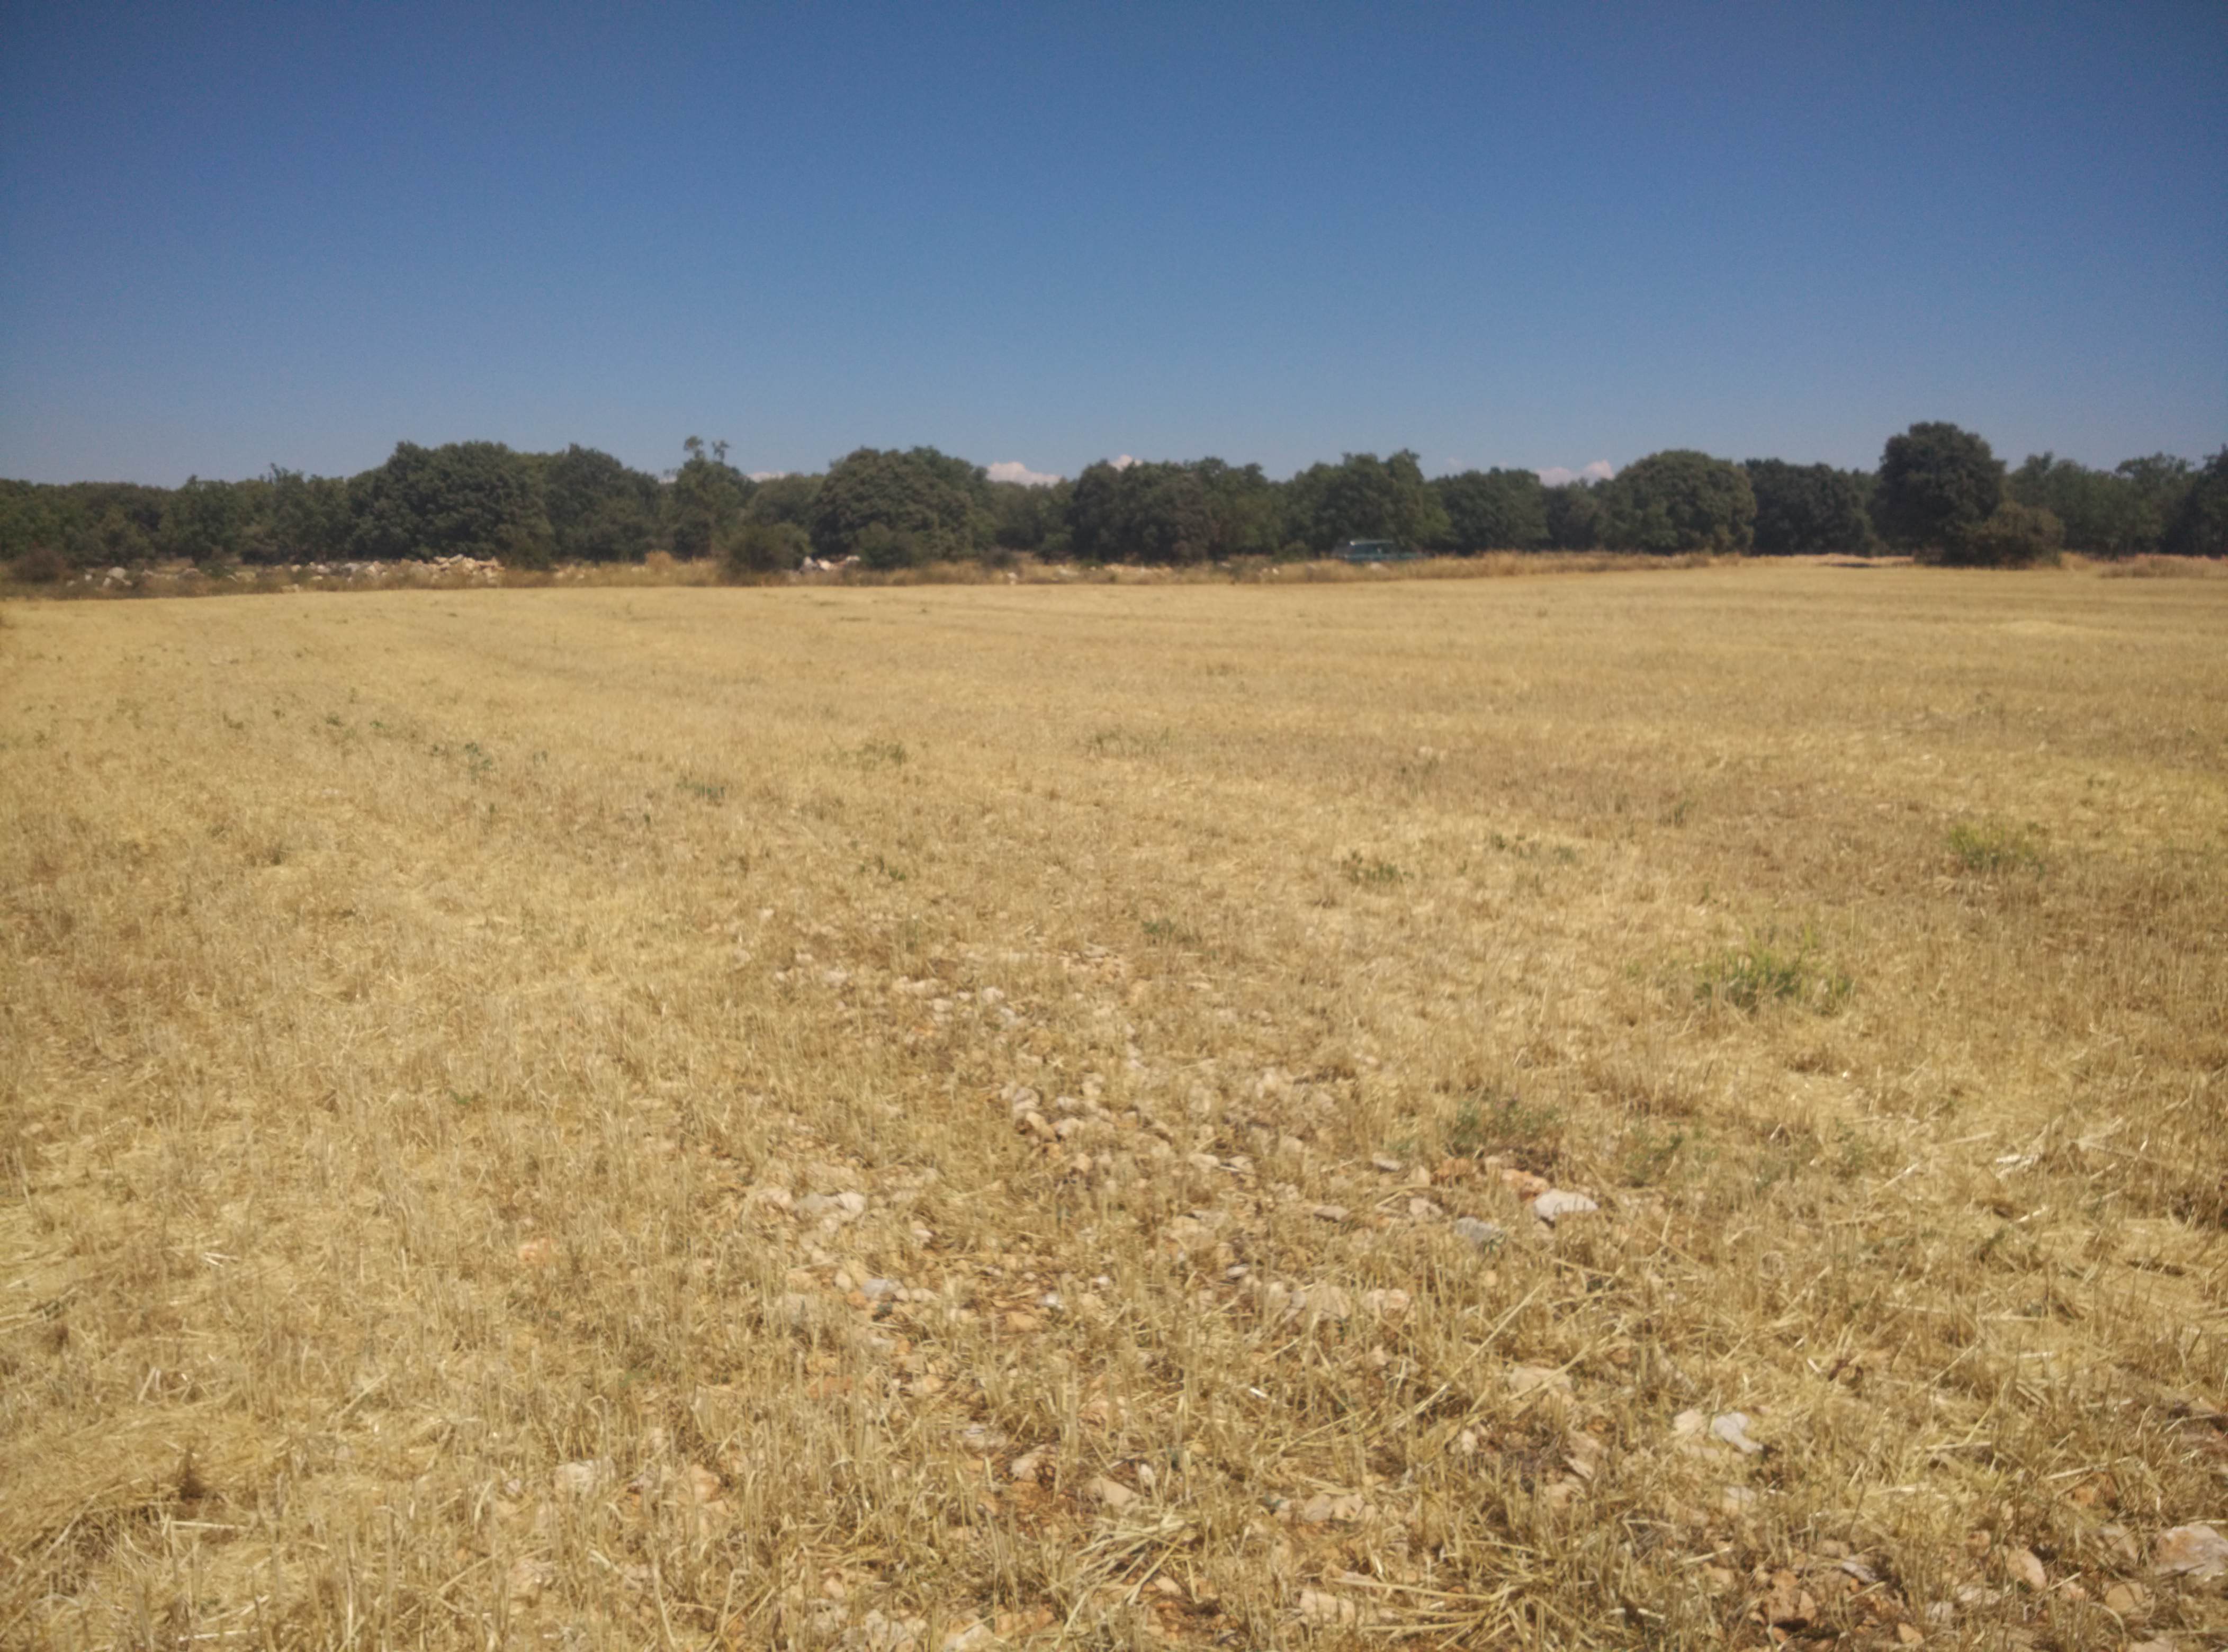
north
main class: Cropland
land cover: Barley
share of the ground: < 10 %
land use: Agriculture (excluding fallow land and kitchen gardens)
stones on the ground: > 50 %
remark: Harvested field
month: July
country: ES
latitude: 40.9127
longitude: -2.8917
